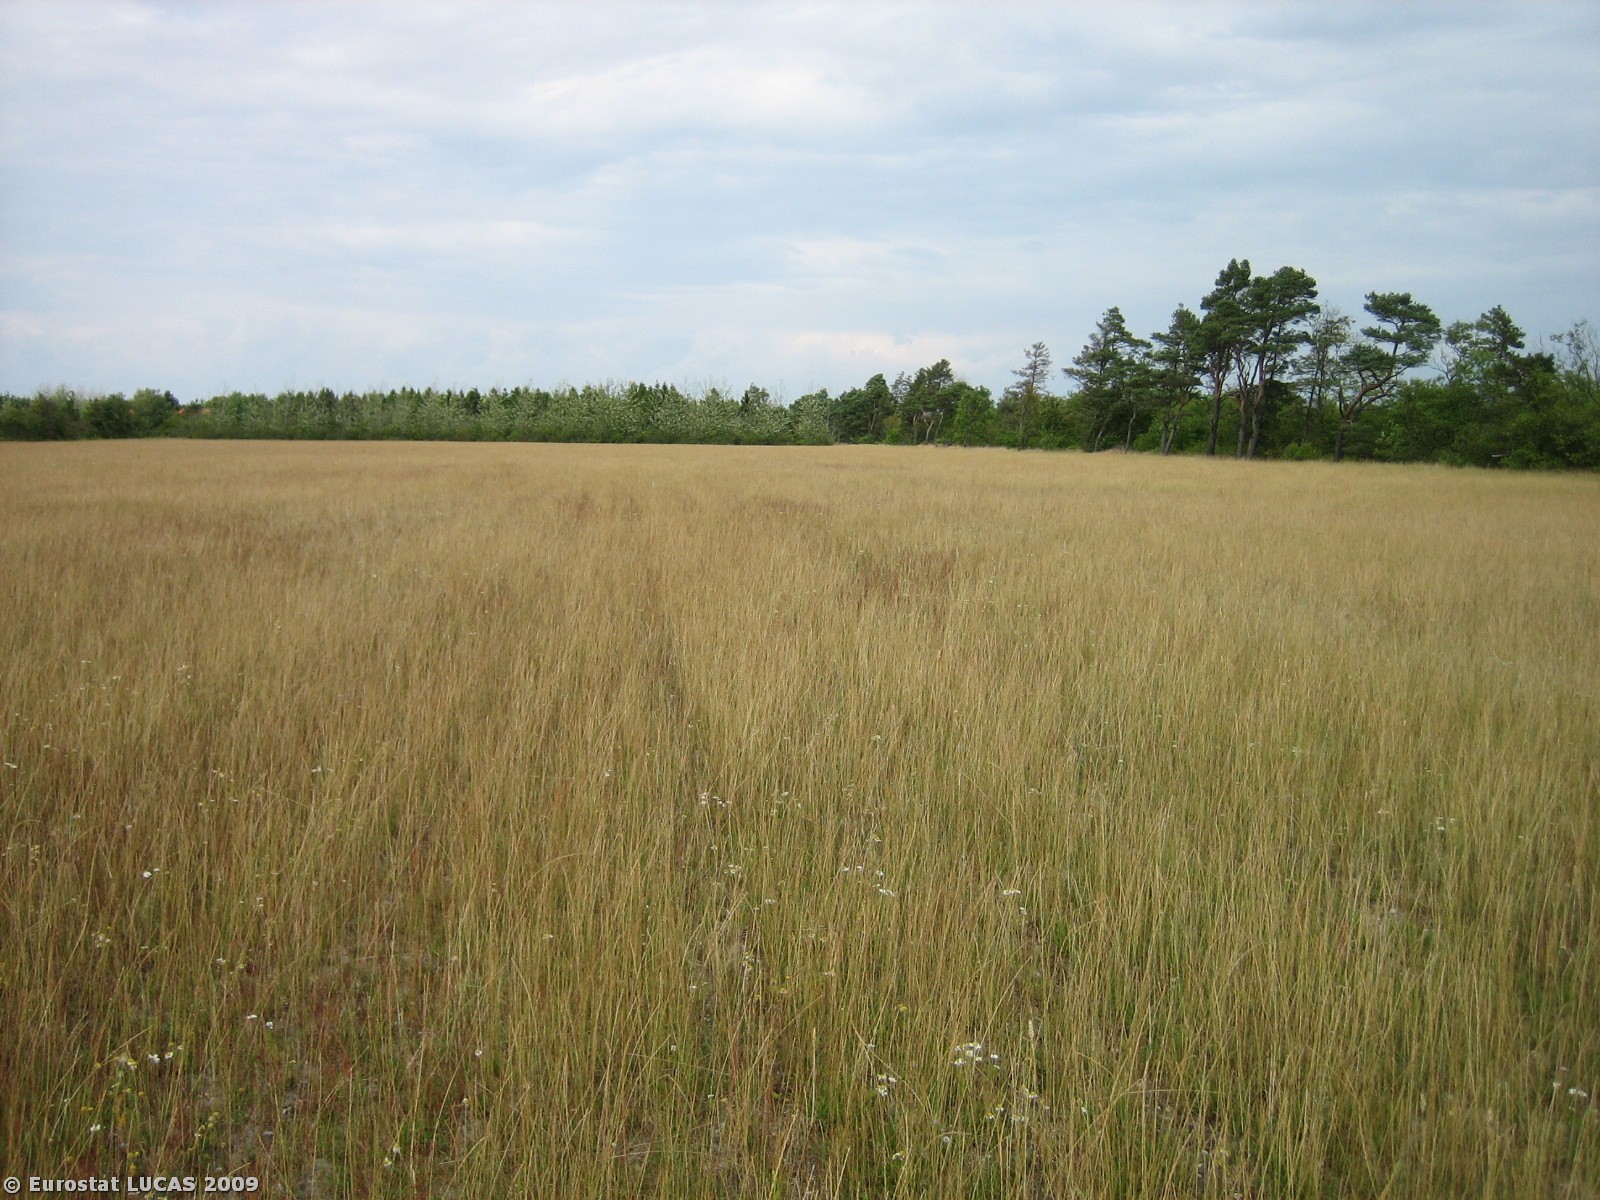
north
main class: Grassland
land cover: Grassland without tree/shrub cover
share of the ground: > 75 %
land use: Fallow land
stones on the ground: 10 - 25 %
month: July
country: DK
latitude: 55.8403
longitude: 8.7717
